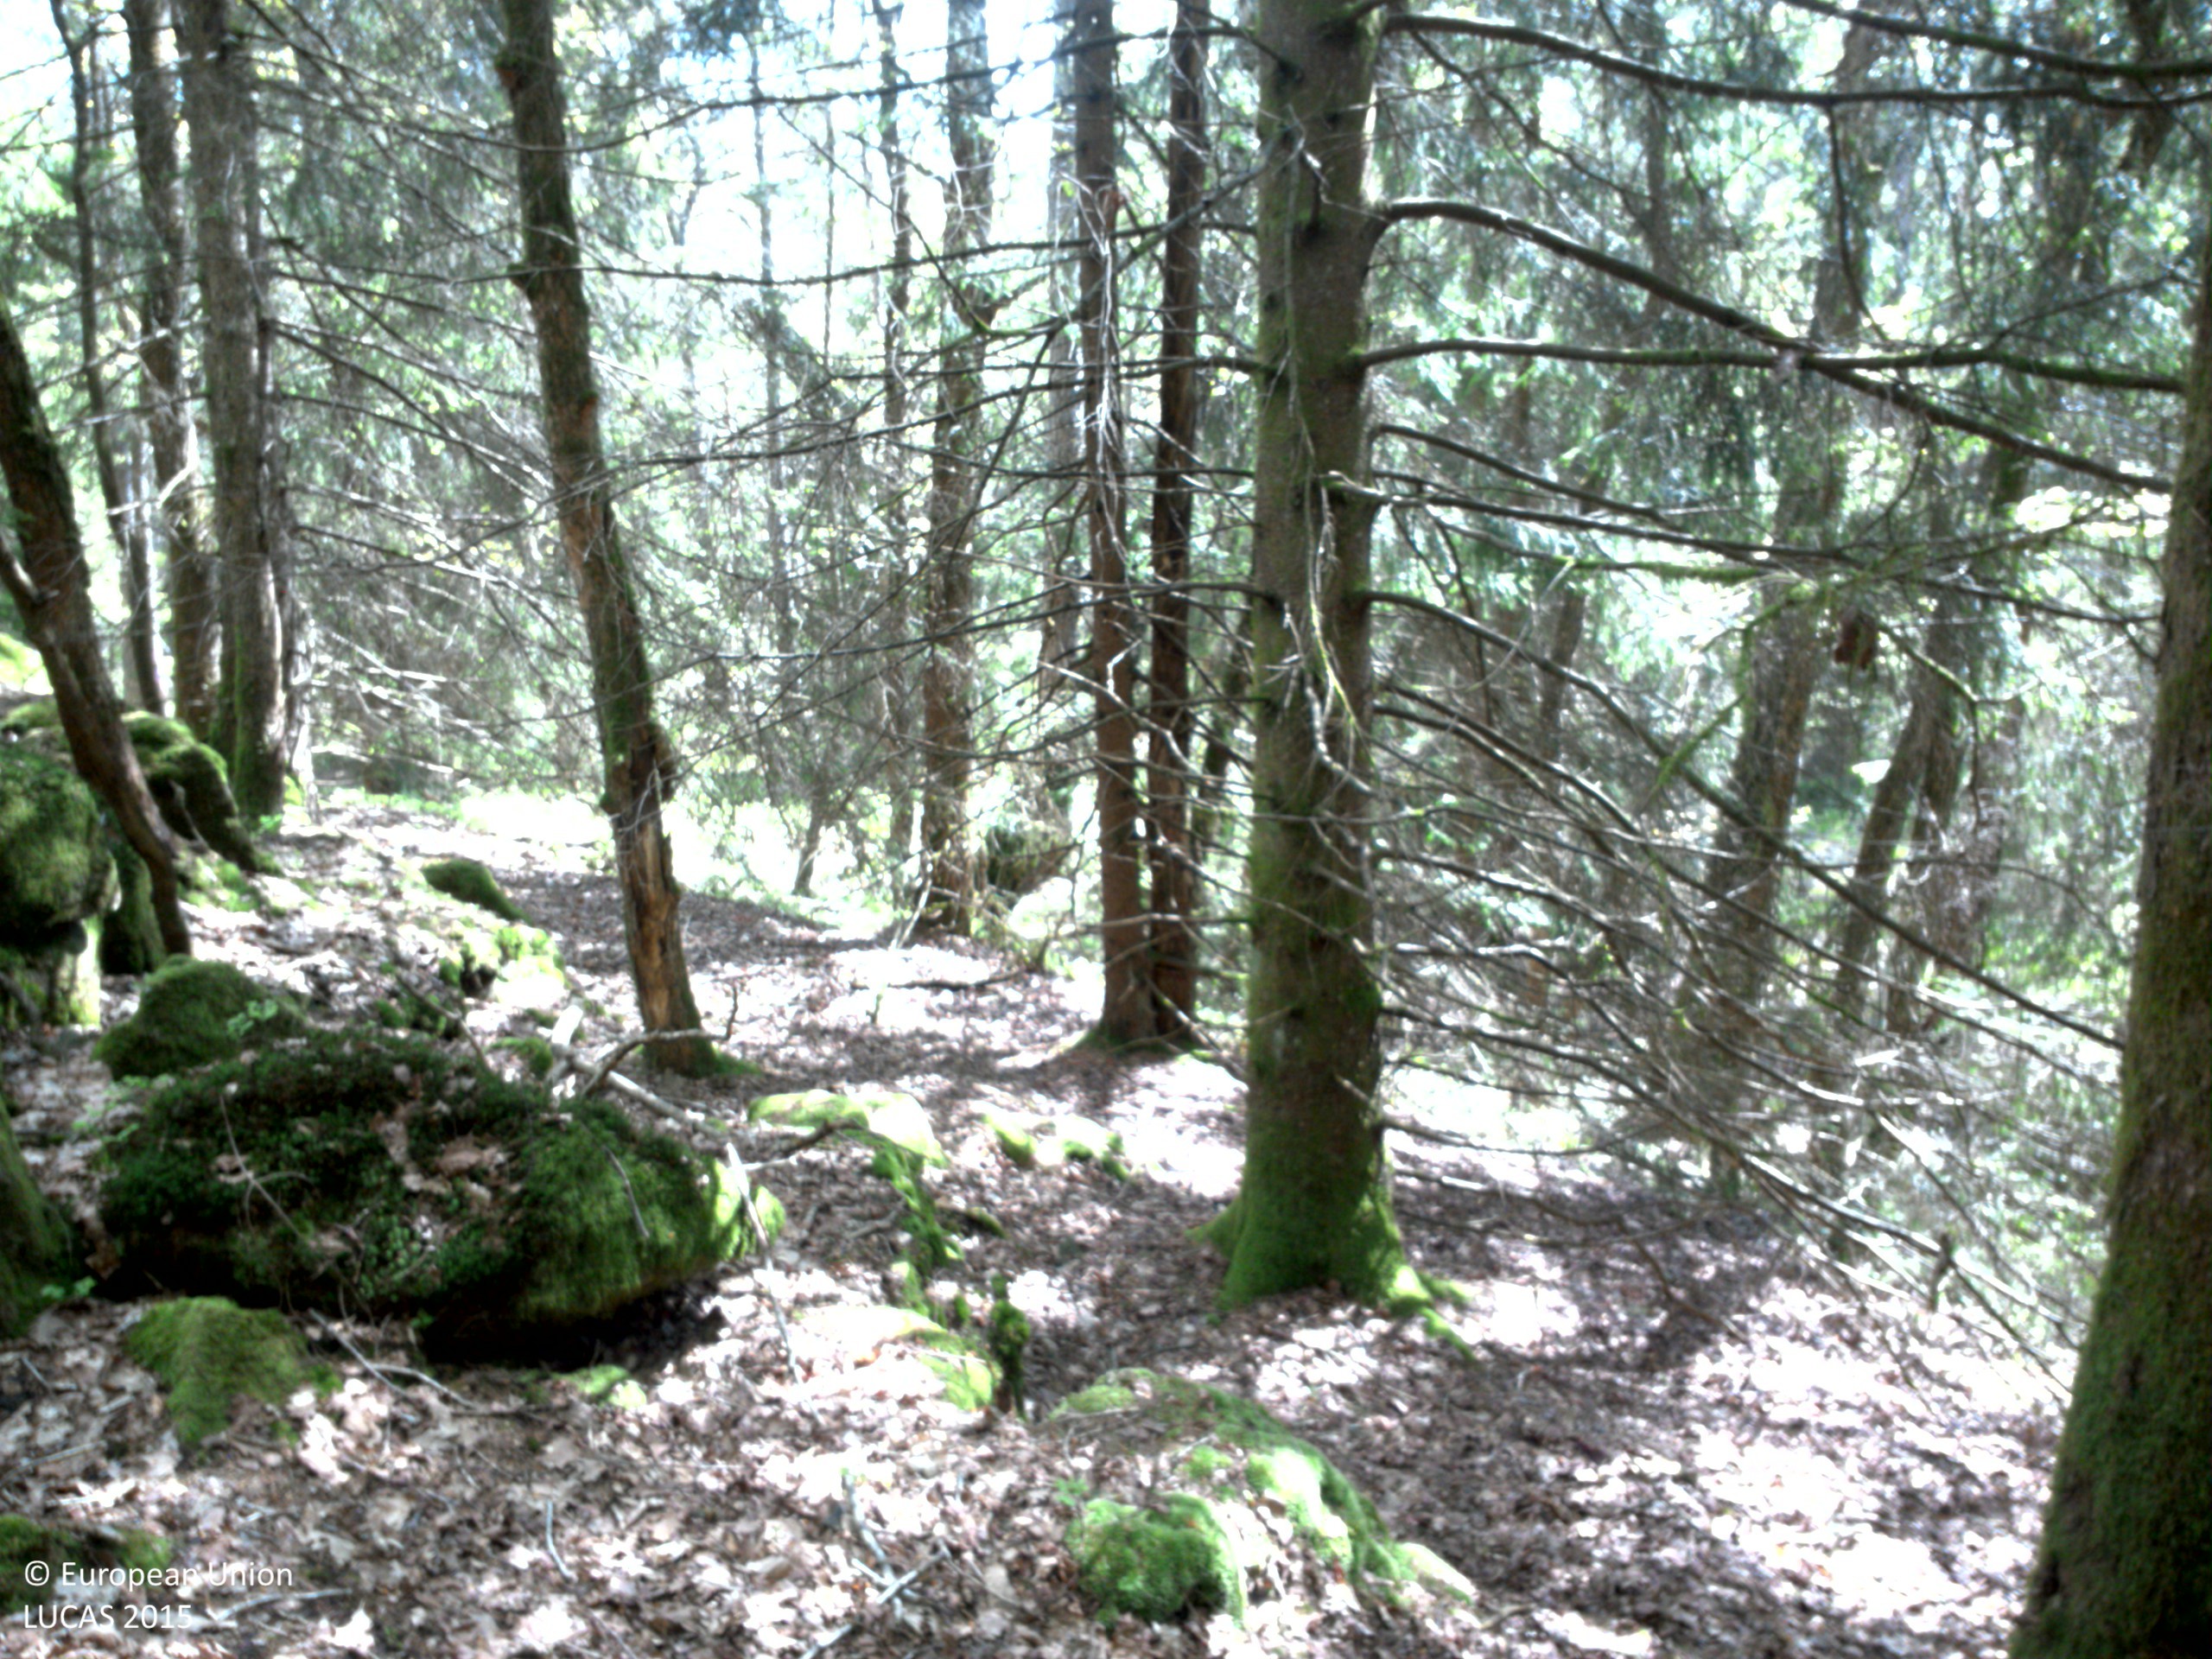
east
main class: Woodland
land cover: Spruce dominated mixed woodland
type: boreal forest
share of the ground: > 75 %
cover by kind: coniferous forest trees 60 %, broadleaved forest trees 20 %, lichens and mosses 10 %, unconsolidated bare surface 10 %
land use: Amenities, museums, leisure
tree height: > 5 m
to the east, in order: Spruce dominated mixed woodland; Ditches and canals; Pine dominated mixed woodland; Tracks; Pine dominated mixed woodland; Spruce dominated mixed woodland
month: May
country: SE
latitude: 57.6978
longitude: 12.1943
